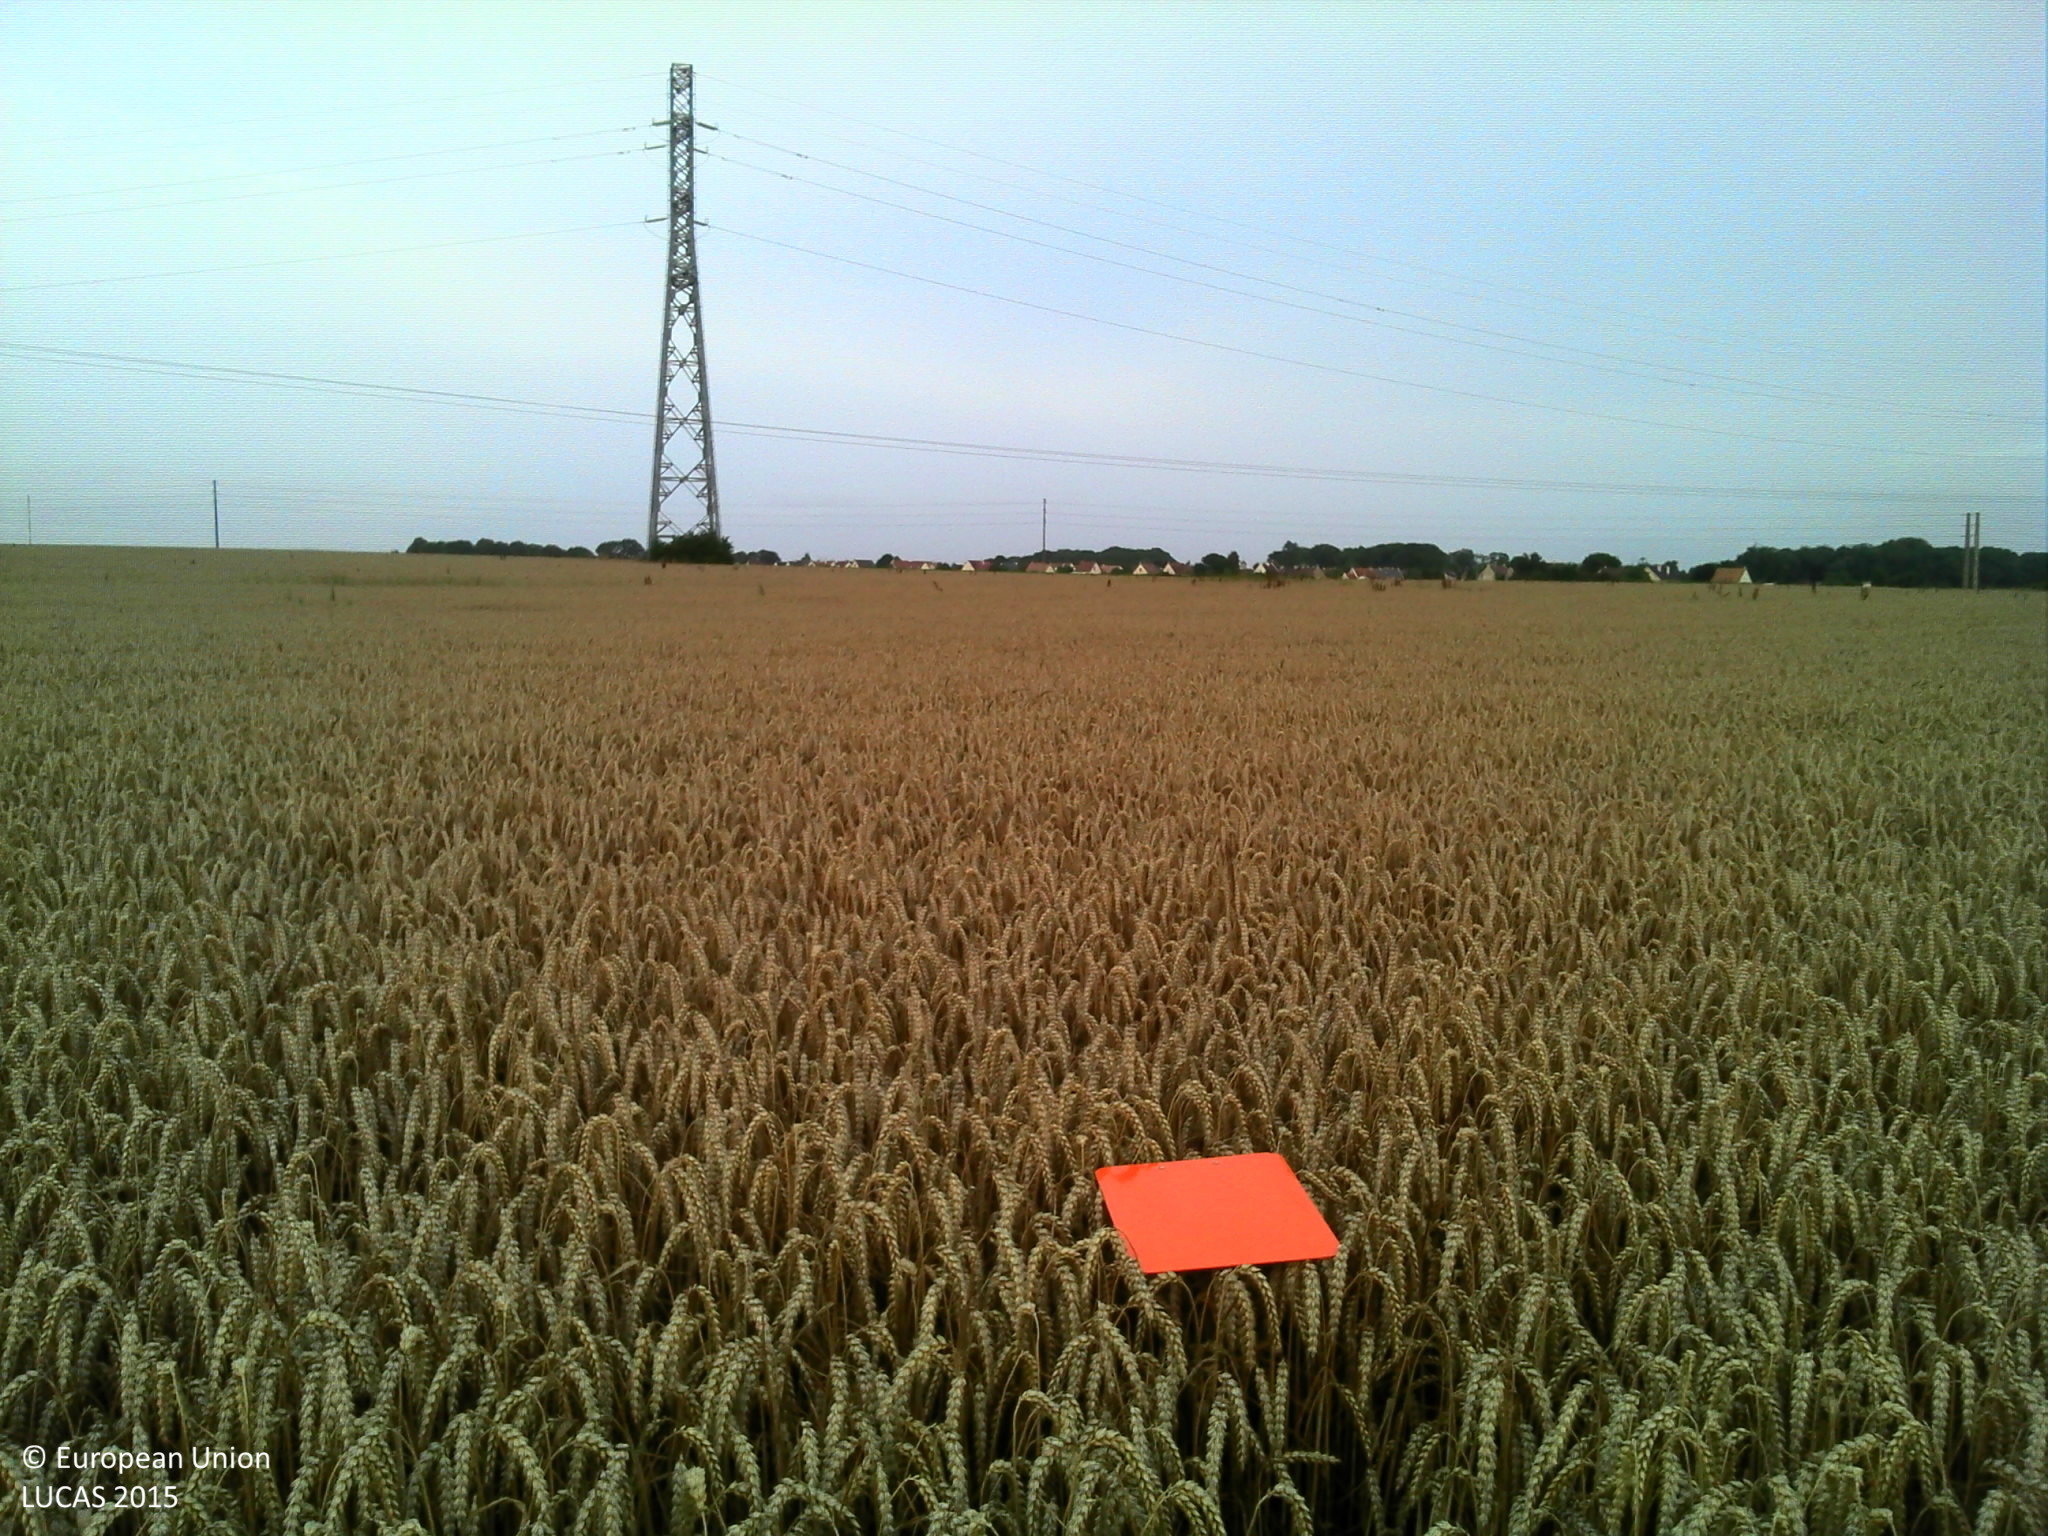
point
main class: Cropland
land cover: Common wheat
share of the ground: > 75 %
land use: Agriculture (excluding fallow land and kitchen gardens)
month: July
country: FR
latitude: 49.2124
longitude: -0.2608
